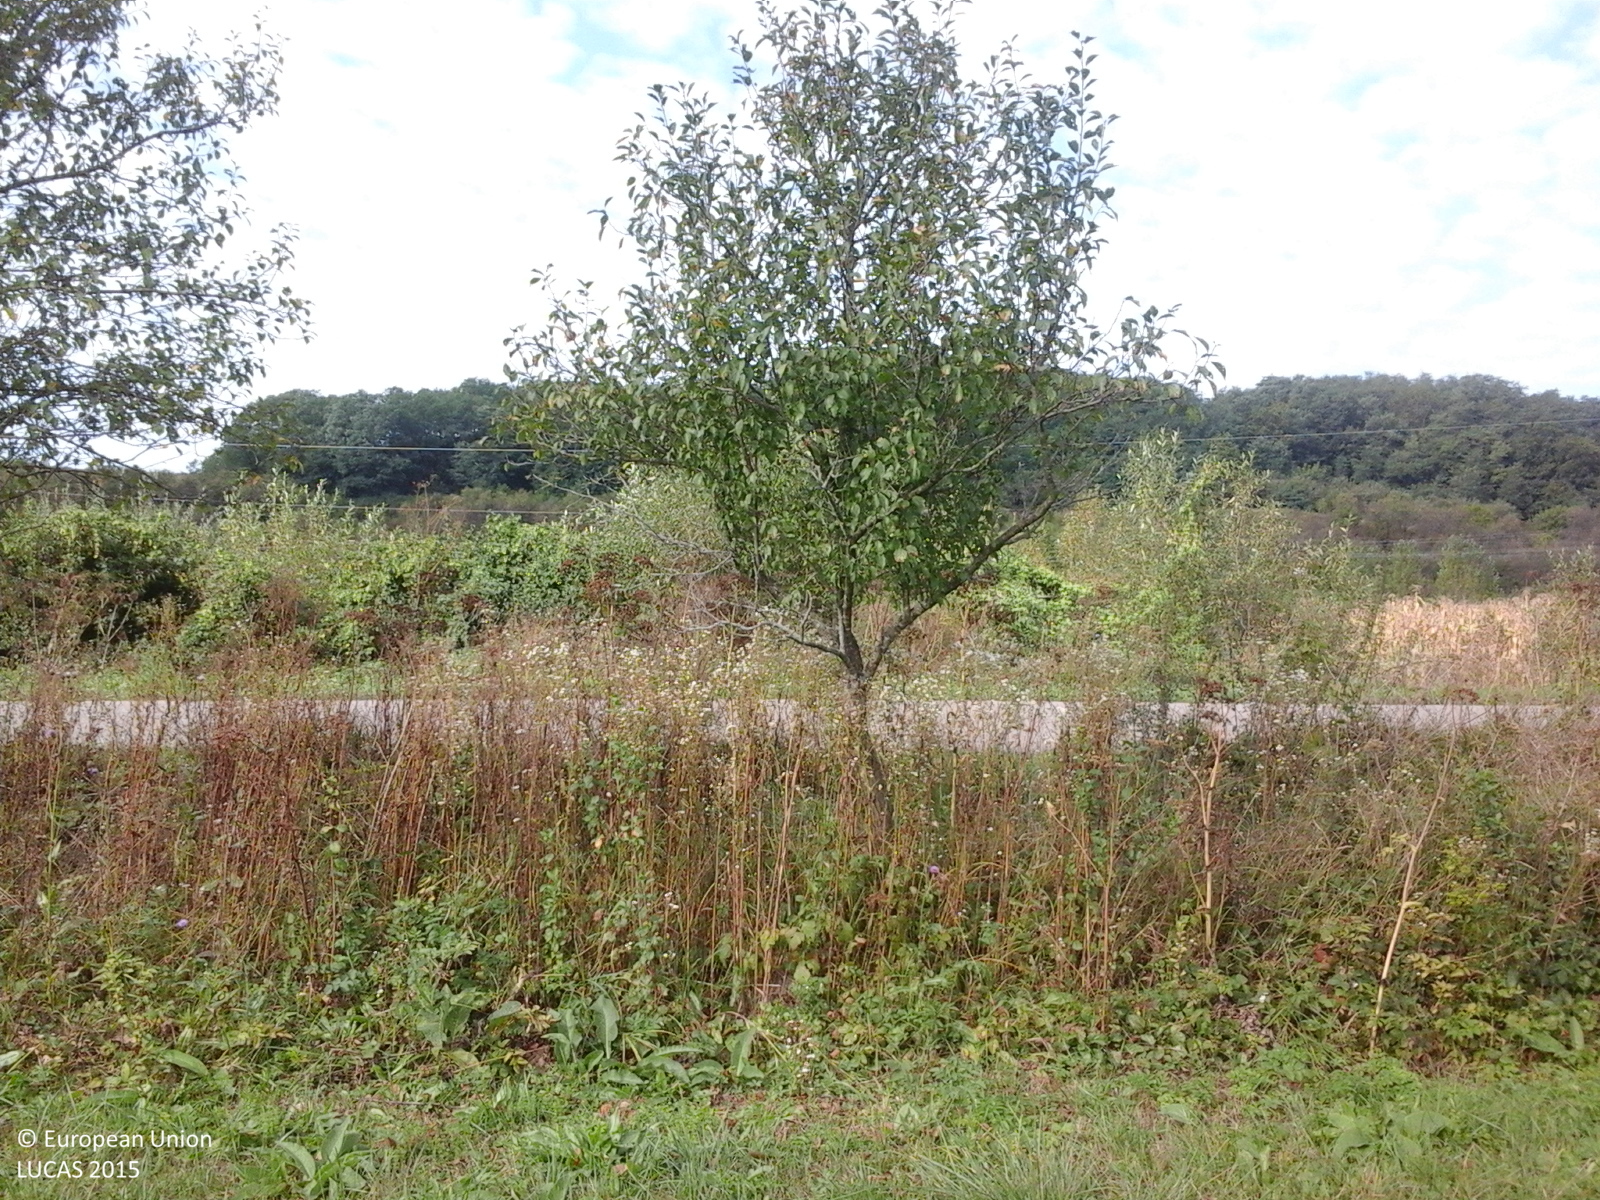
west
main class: Grassland
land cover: Grassland without tree/shrub cover
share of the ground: > 75 %
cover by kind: herbaceous plants 100 %
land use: Agriculture (excluding fallow land and kitchen gardens)
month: September
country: RO
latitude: 47.3927
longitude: 23.1699
